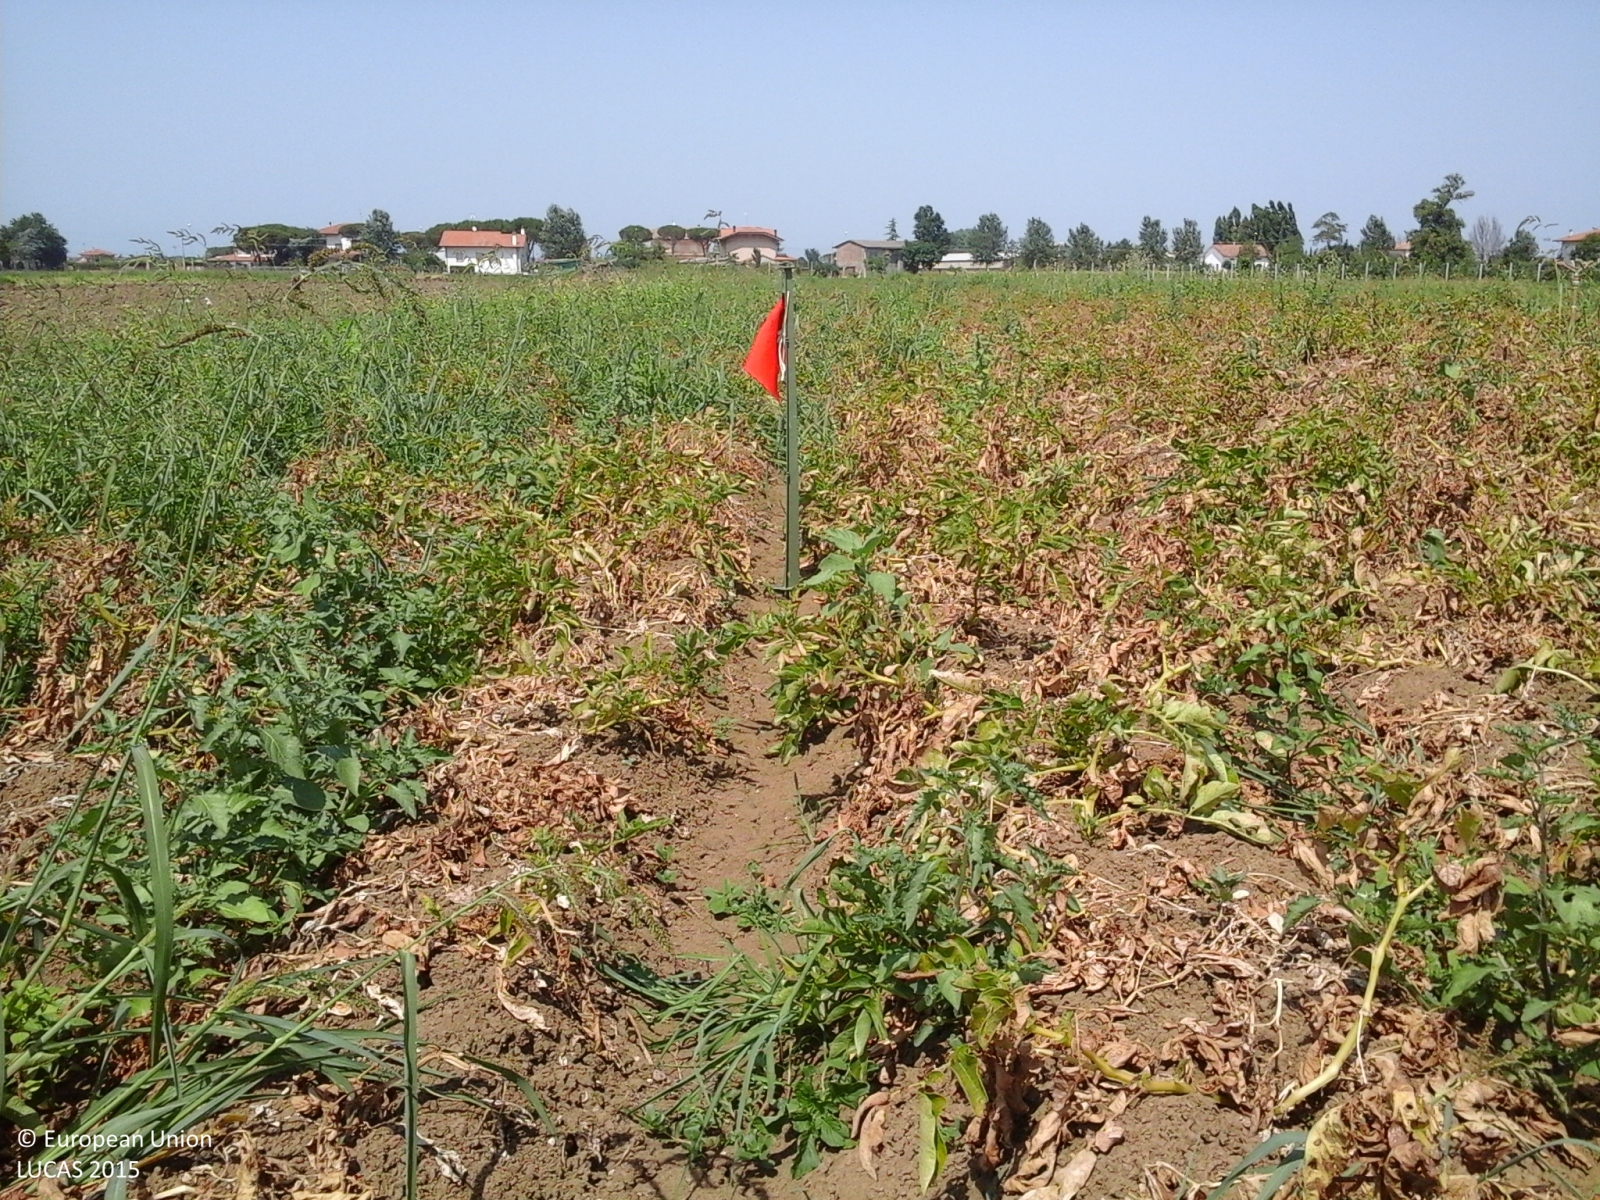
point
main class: Cropland
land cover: Potatoes
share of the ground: > 75 %
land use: Agriculture (excluding fallow land and kitchen gardens)
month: July
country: IT
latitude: 44.1416
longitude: 12.4322
